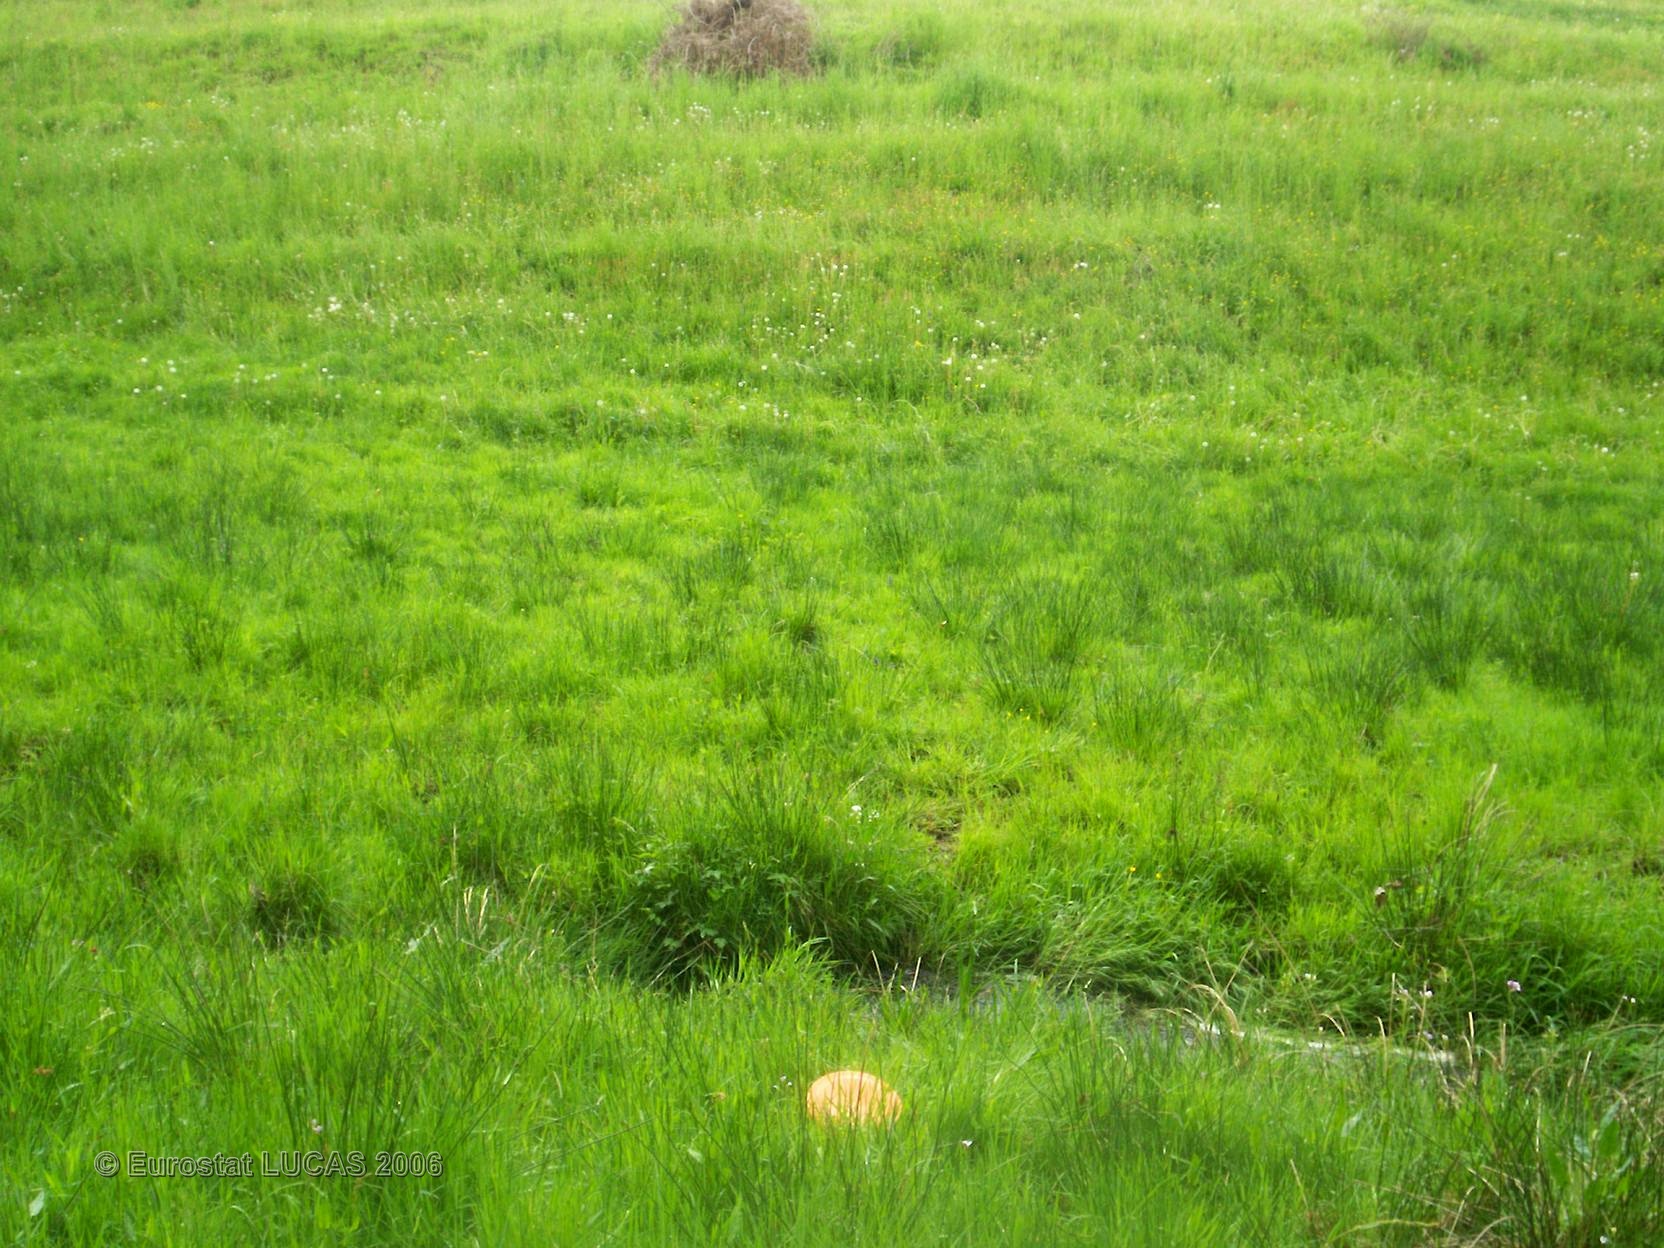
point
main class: Grassland
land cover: Grassland without tree/shrub cover
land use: Agriculture (excluding fallow land and kitchen gardens)
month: May
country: FR
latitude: 45.7288
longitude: 1.5765
